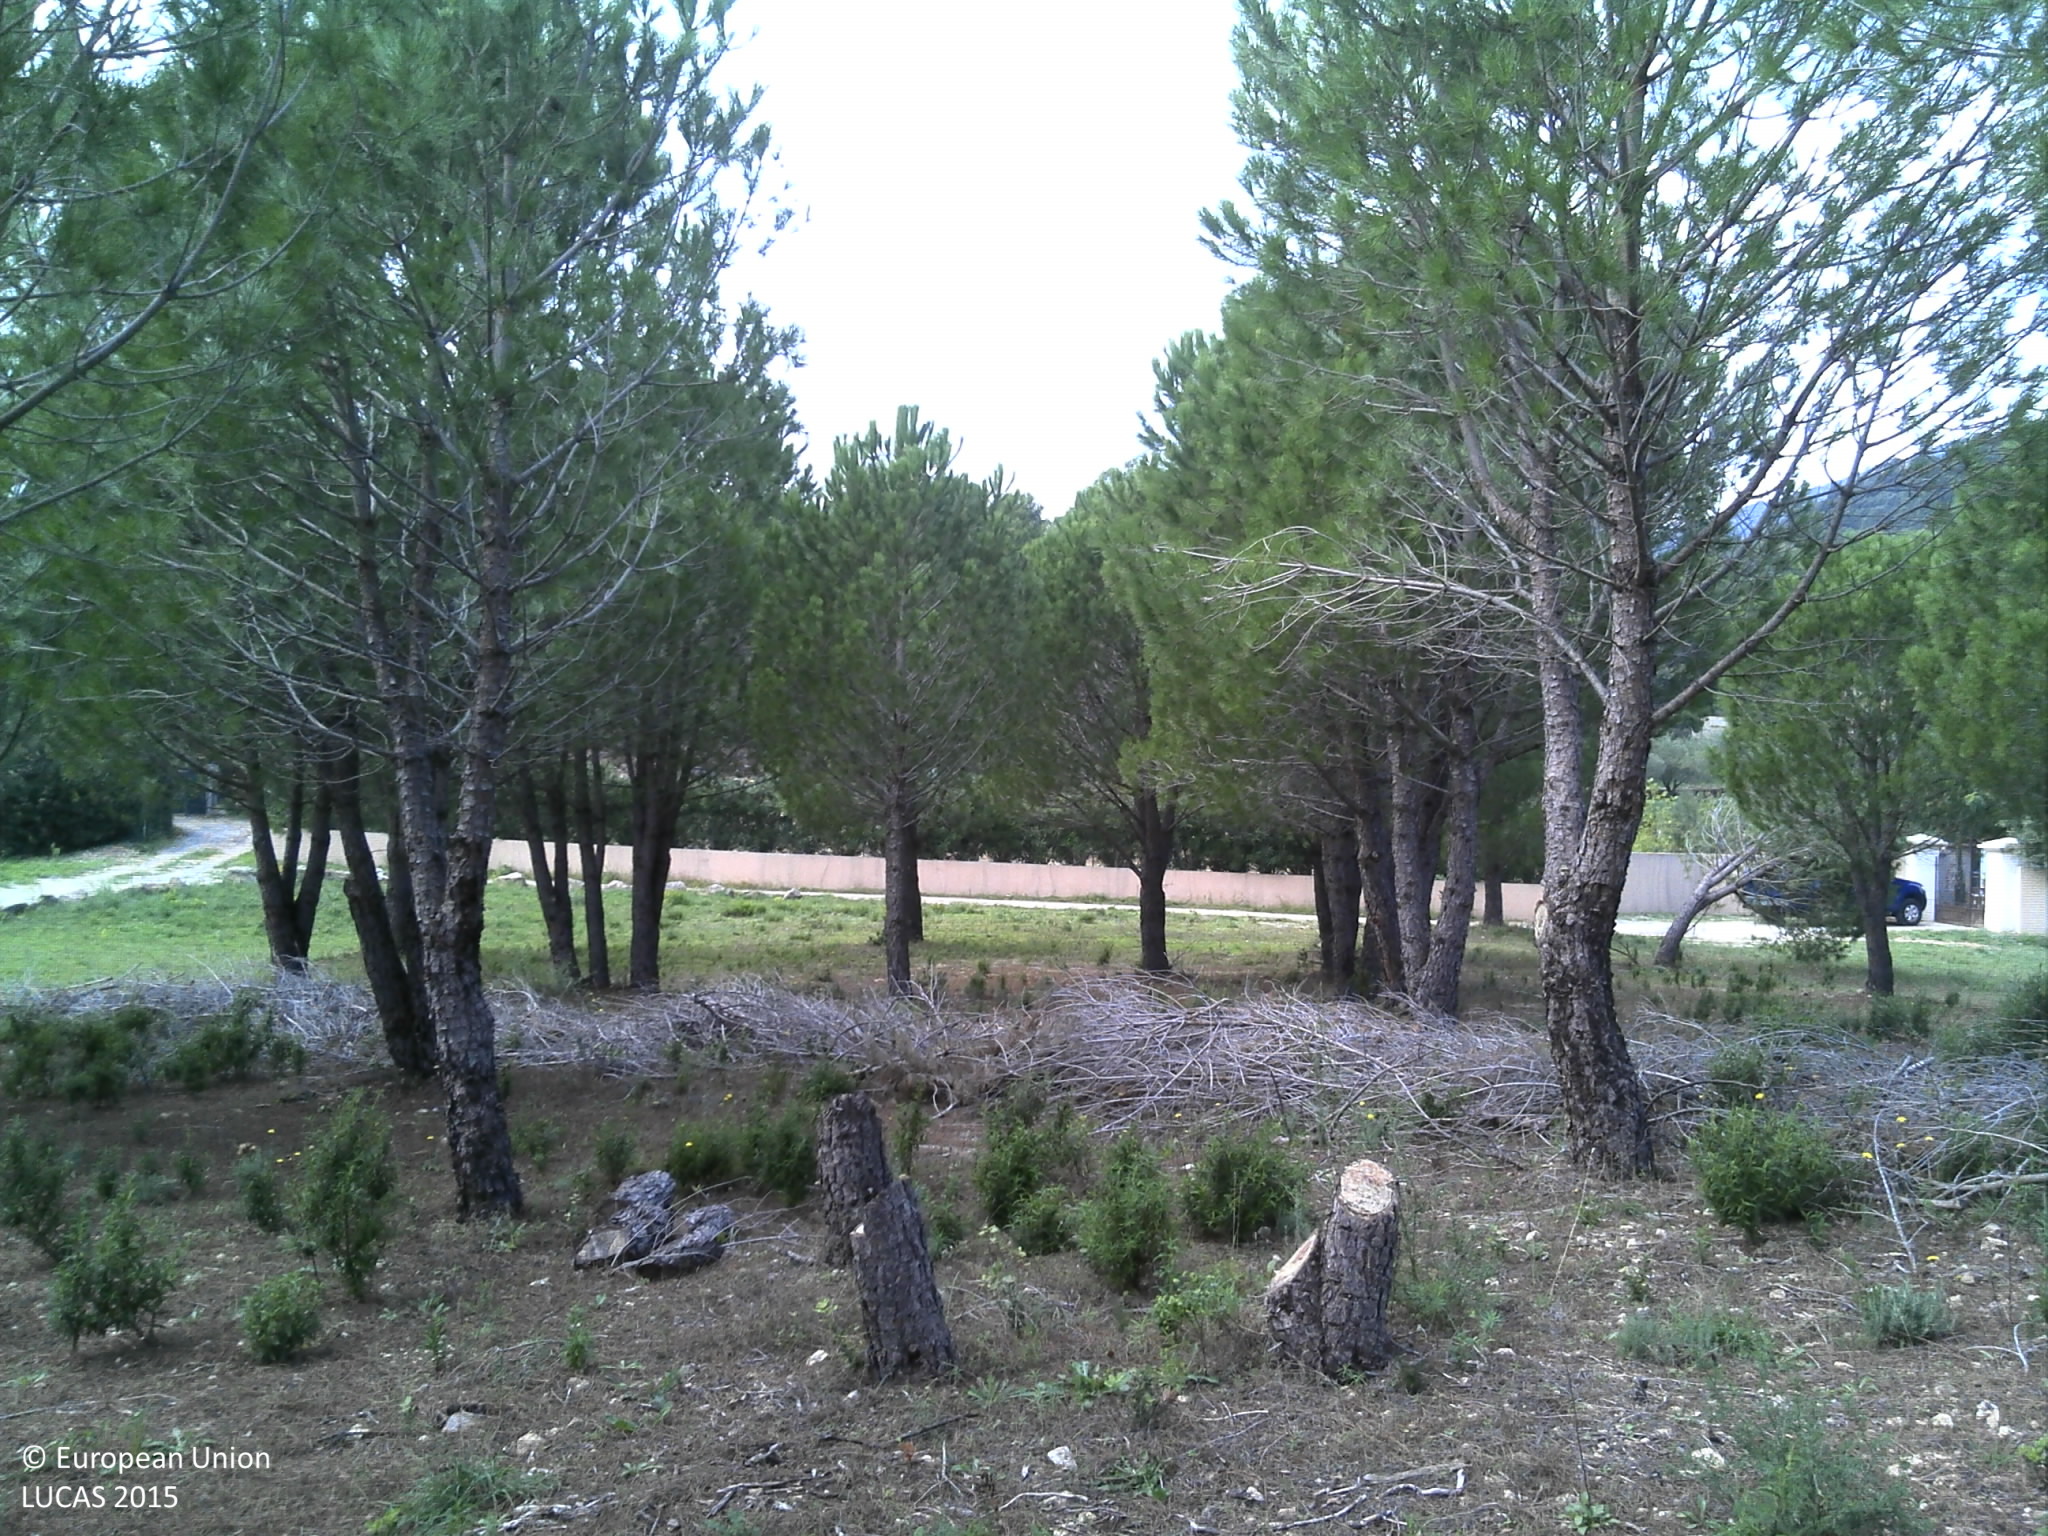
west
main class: Woodland
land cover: Pine dominated coniferous woodland
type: coniferous forest of the mediterranean region
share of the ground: 50 - 75 %
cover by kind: coniferous forest trees 50 %, unconsolidated bare surface 30 %, shrubs 10 %, herbaceous plants 5 %
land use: Forestry
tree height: > 5 m
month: October
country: FR
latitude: 43.3359
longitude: 6.5429
